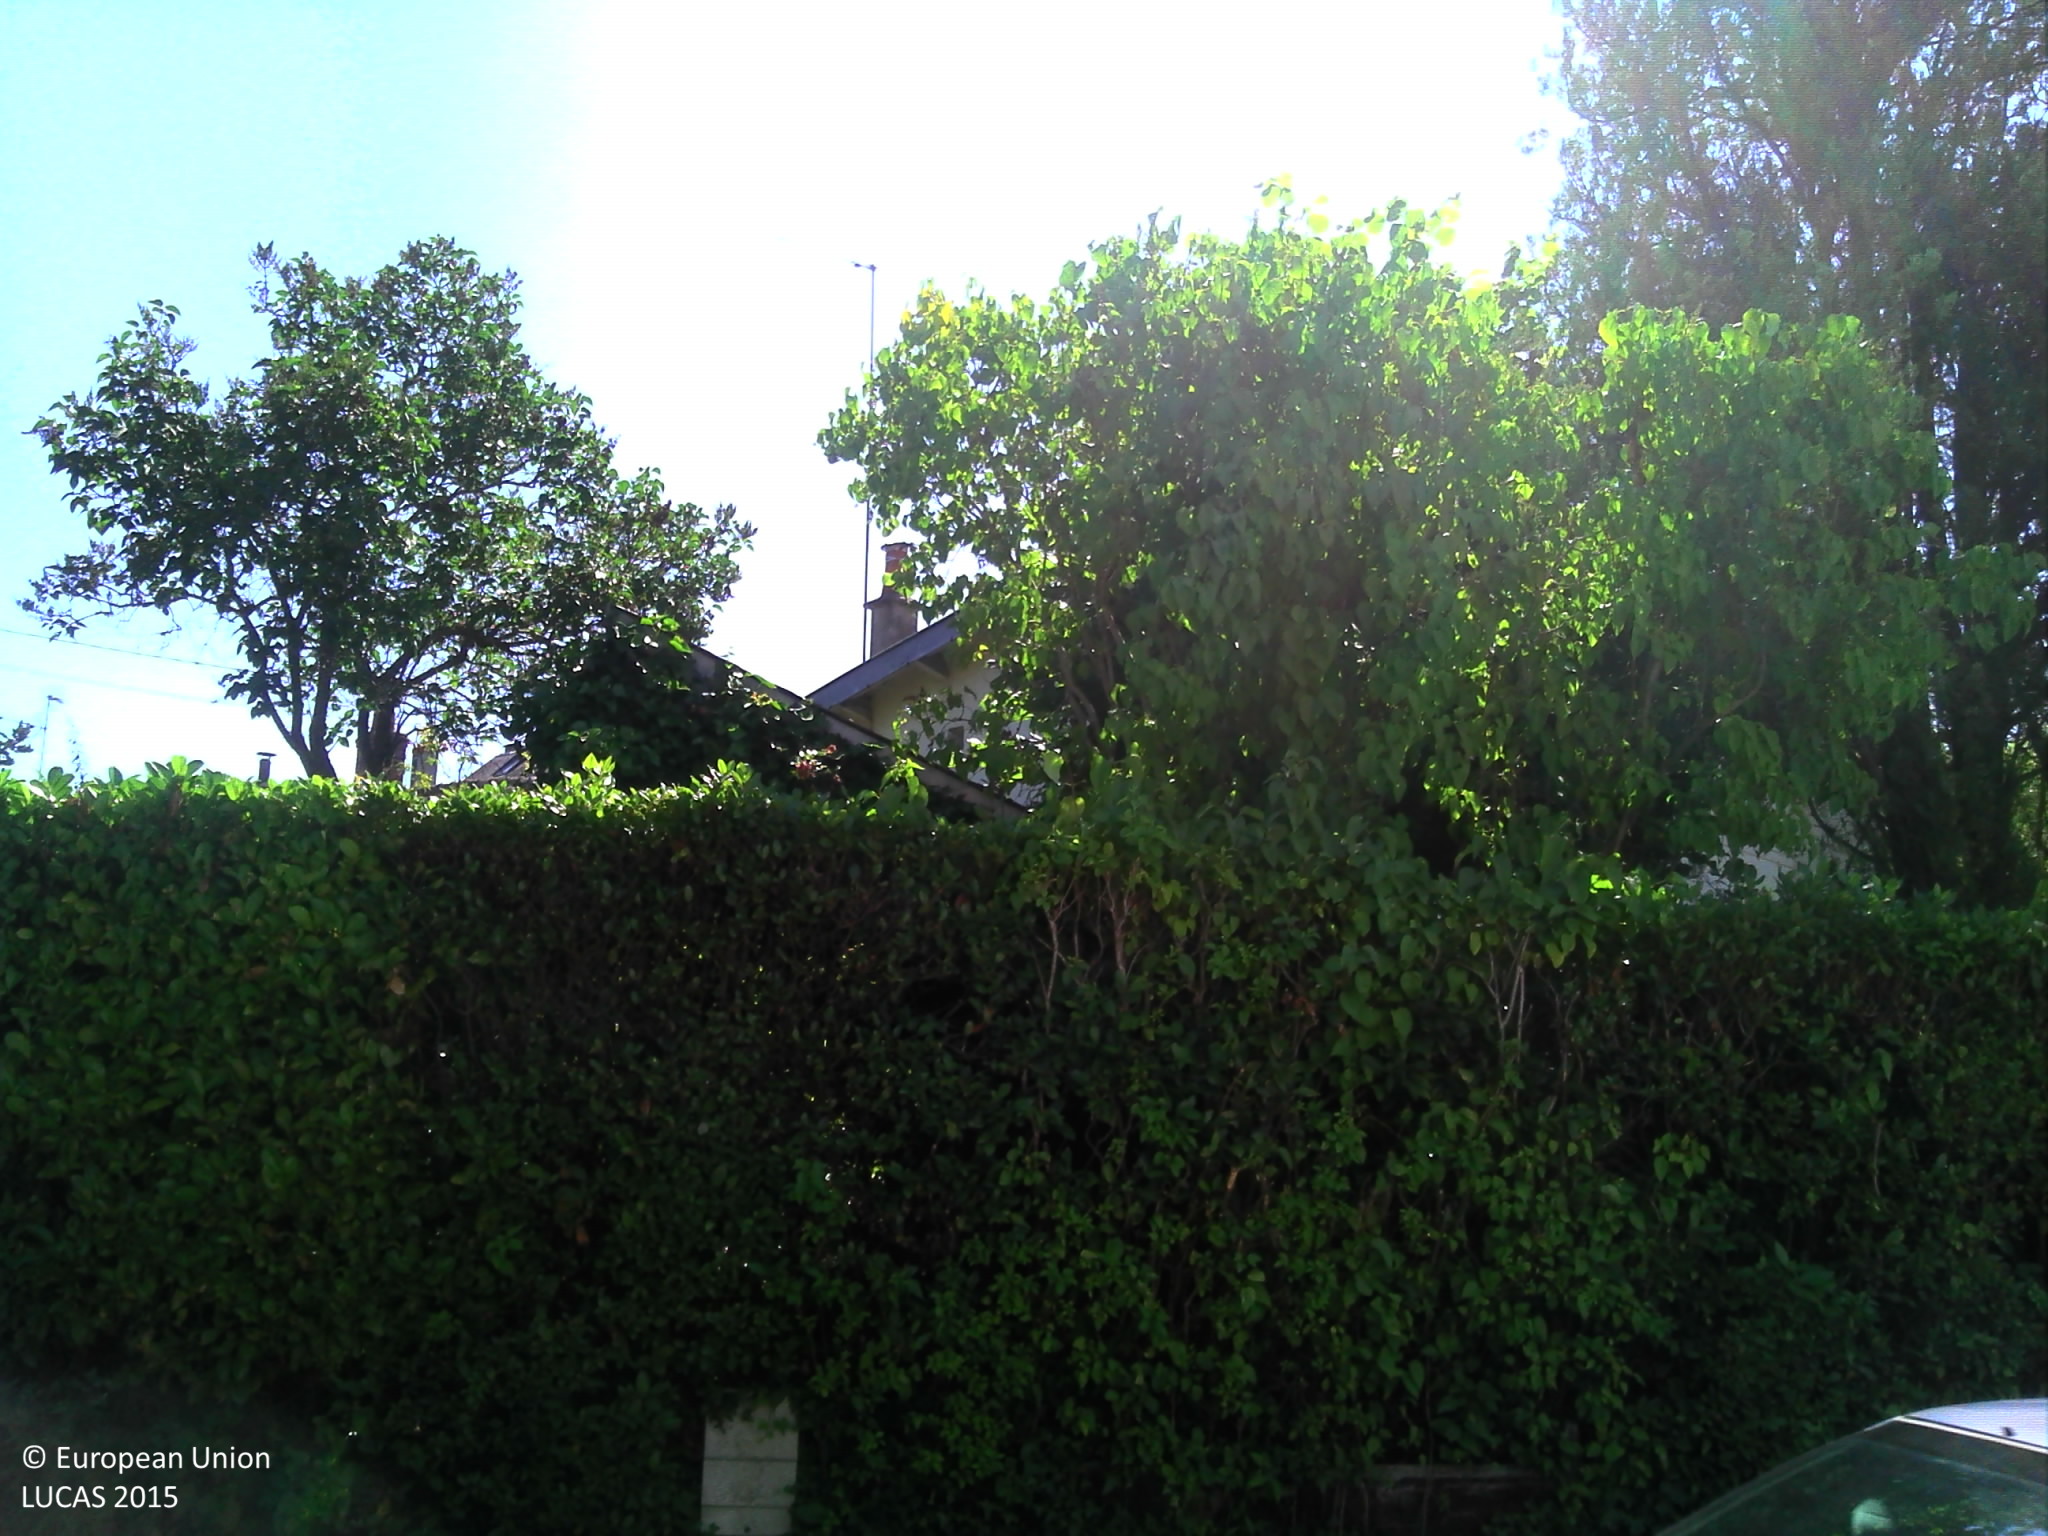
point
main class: Grassland
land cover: Grassland with sparse tree/shrub cover
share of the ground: > 75 %
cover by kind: herbaceous plants 95 %, broadleaved forest trees 5 %
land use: Residential
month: June
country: FR
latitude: 47.4122
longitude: 0.6900
